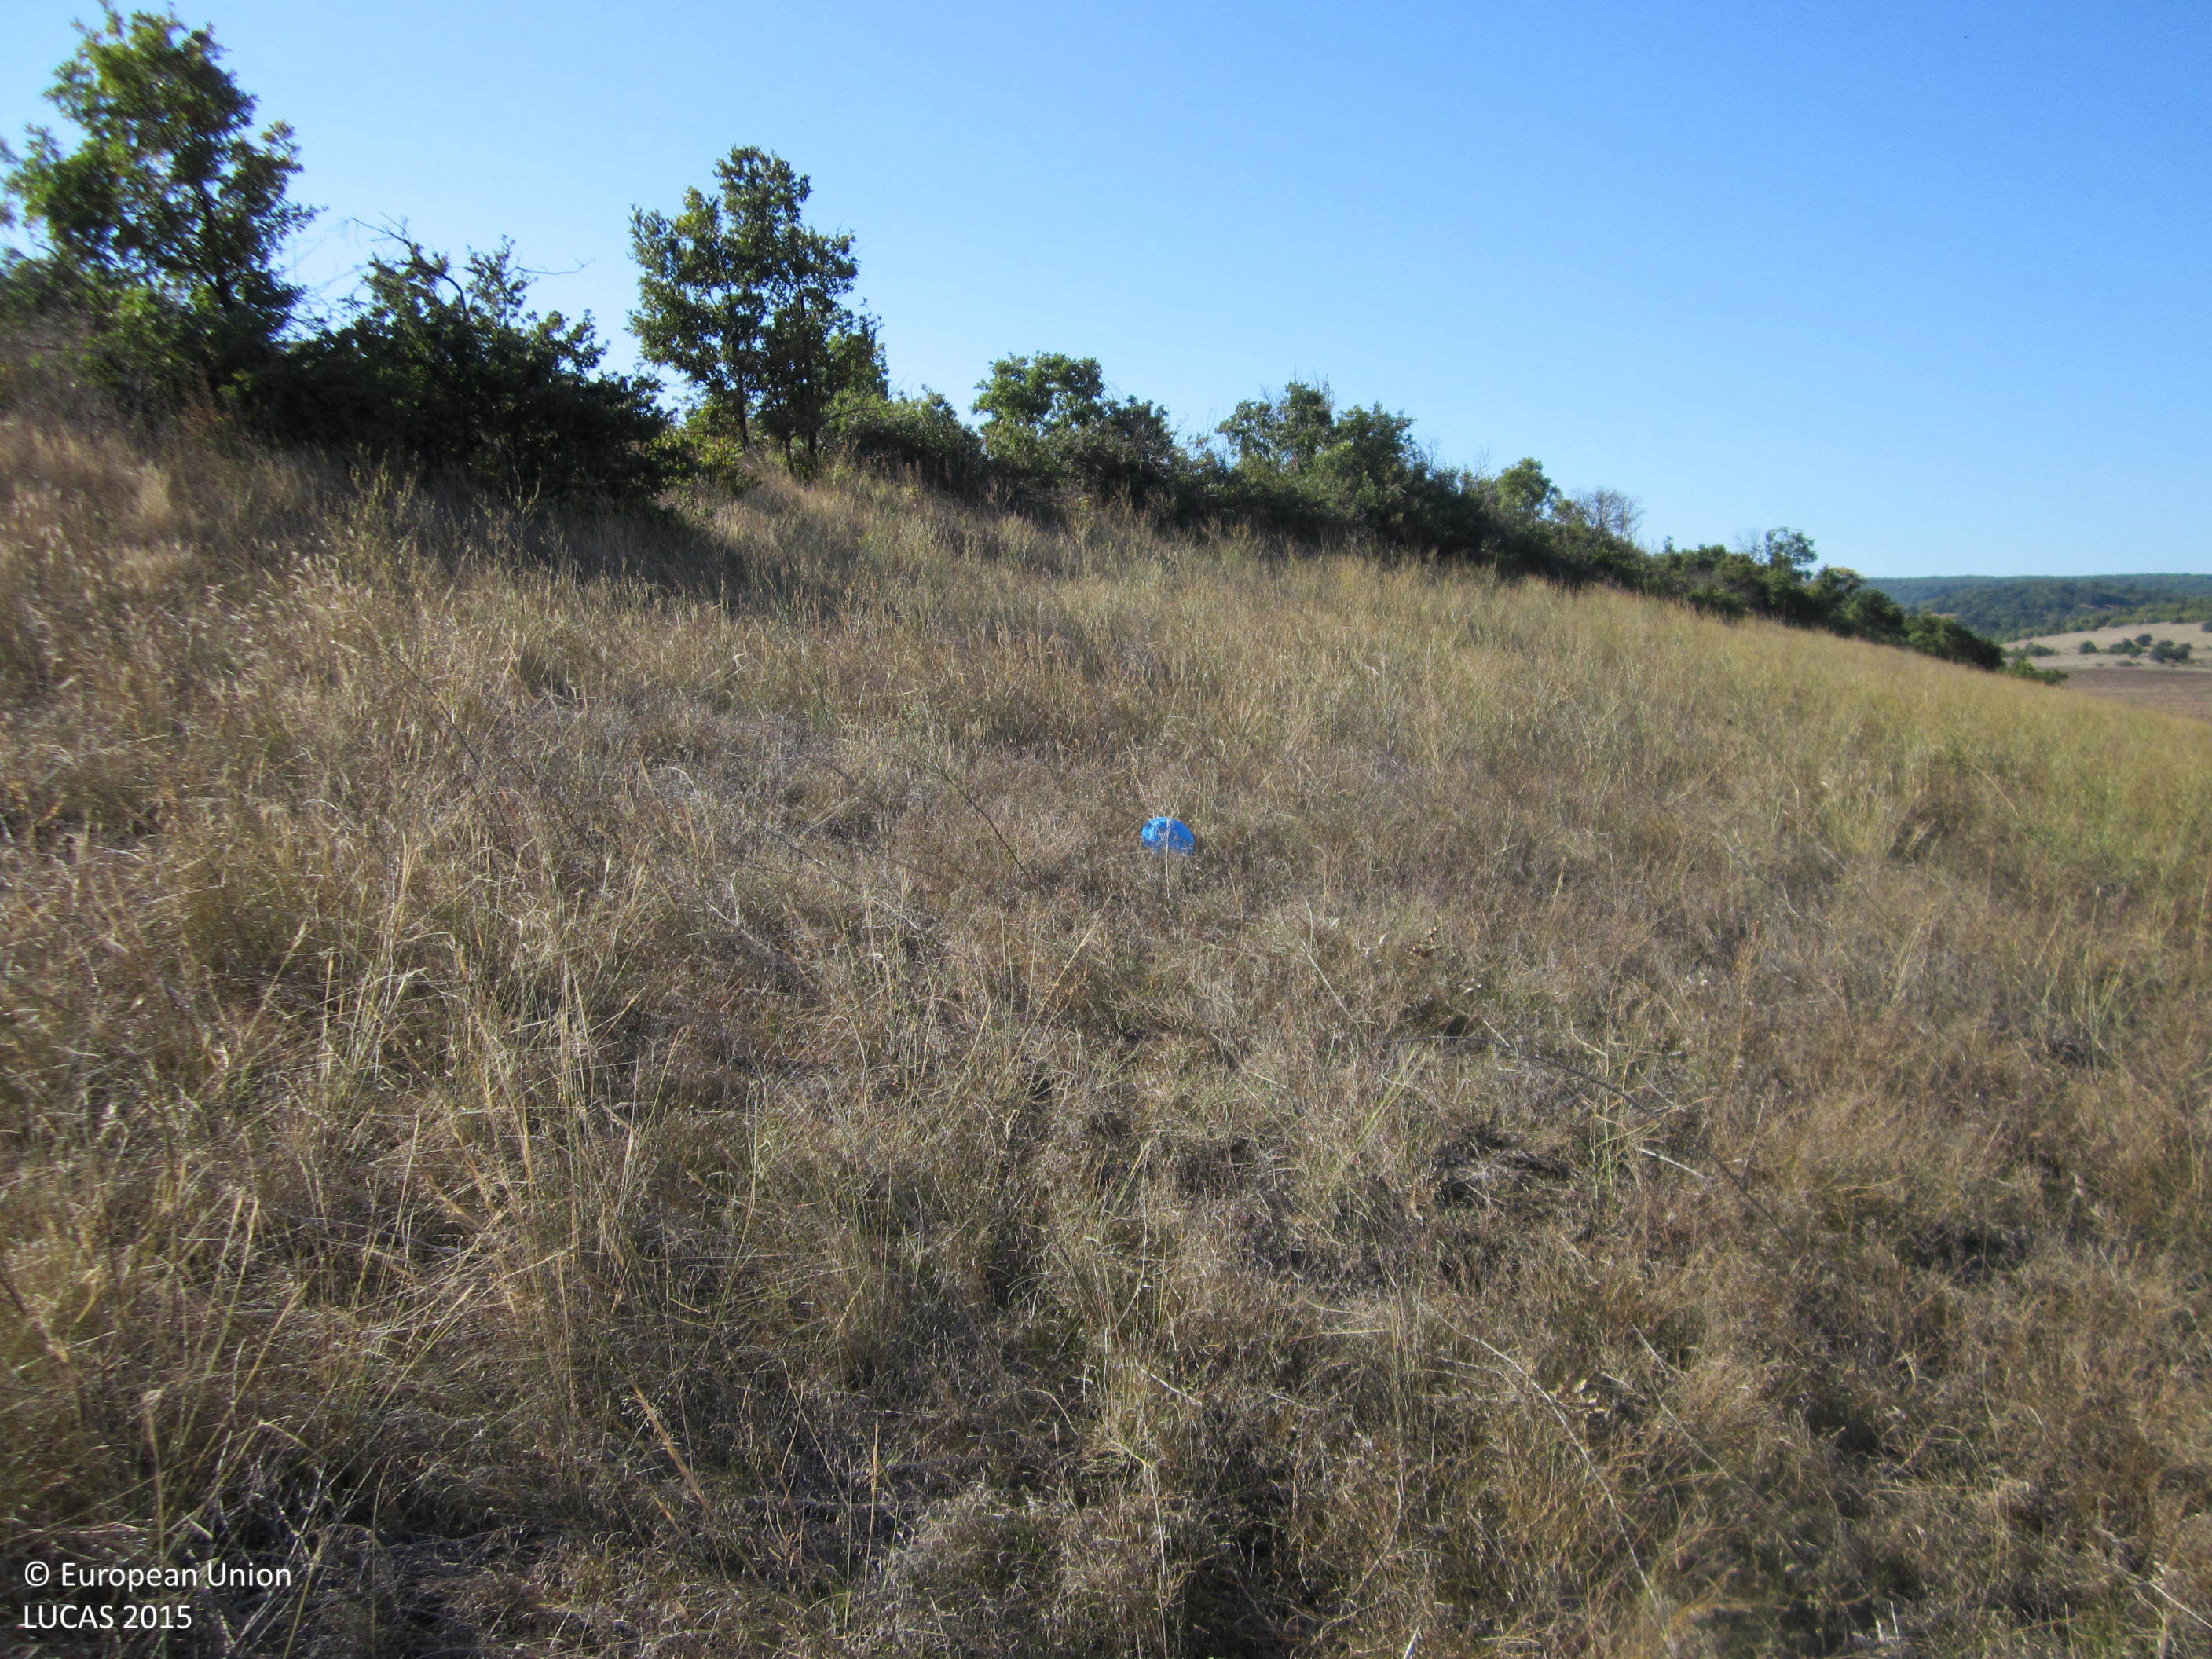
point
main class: Grassland
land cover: Grassland without tree/shrub cover
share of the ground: > 75 %
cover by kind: herbaceous plants 100 %
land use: Agriculture (excluding fallow land and kitchen gardens)
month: September
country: BG
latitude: 42.7363
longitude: 27.3016
